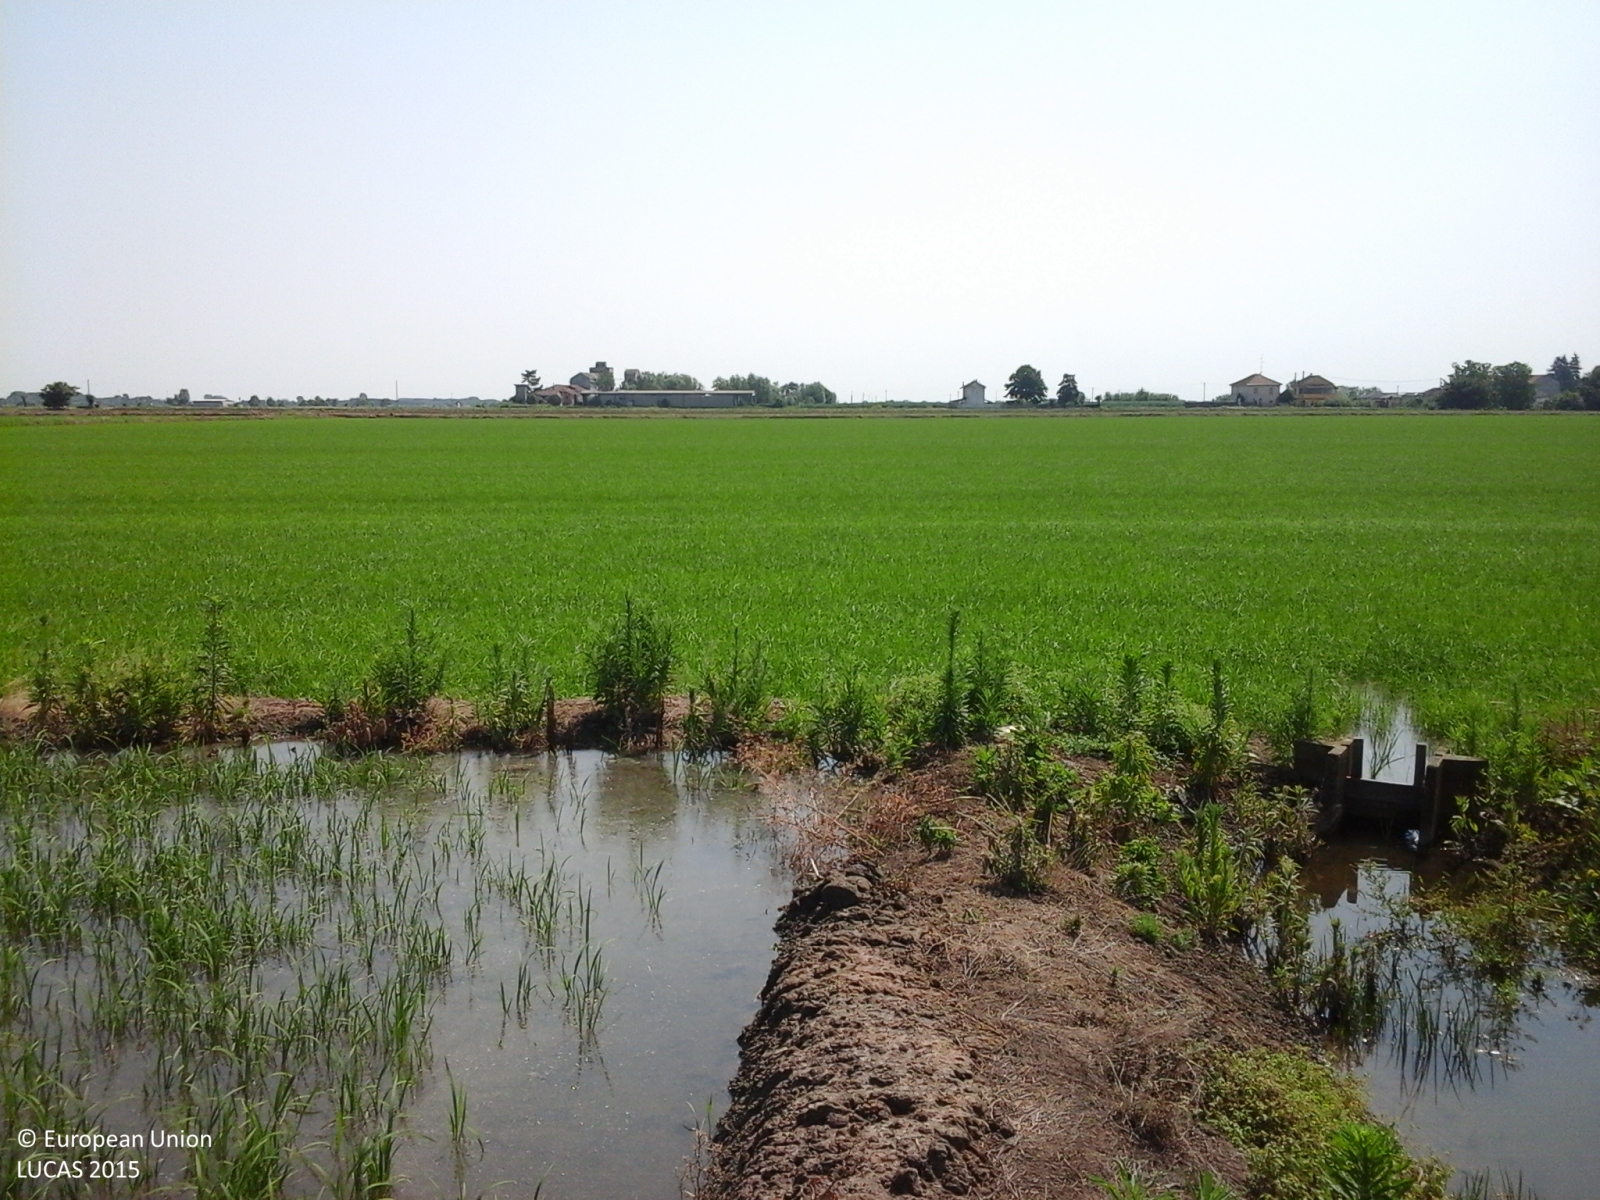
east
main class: Cropland
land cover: Rice
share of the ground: 25 - 50 %
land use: Agriculture (excluding fallow land and kitchen gardens)
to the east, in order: Rice; Other structural elements; Rice; Ditches and canals; Rice; Ditches and canals; Rice; Other structural elements; Ditches and canals; Other structural elements; Rice
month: July
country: IT
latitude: 45.2401
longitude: 8.4104
